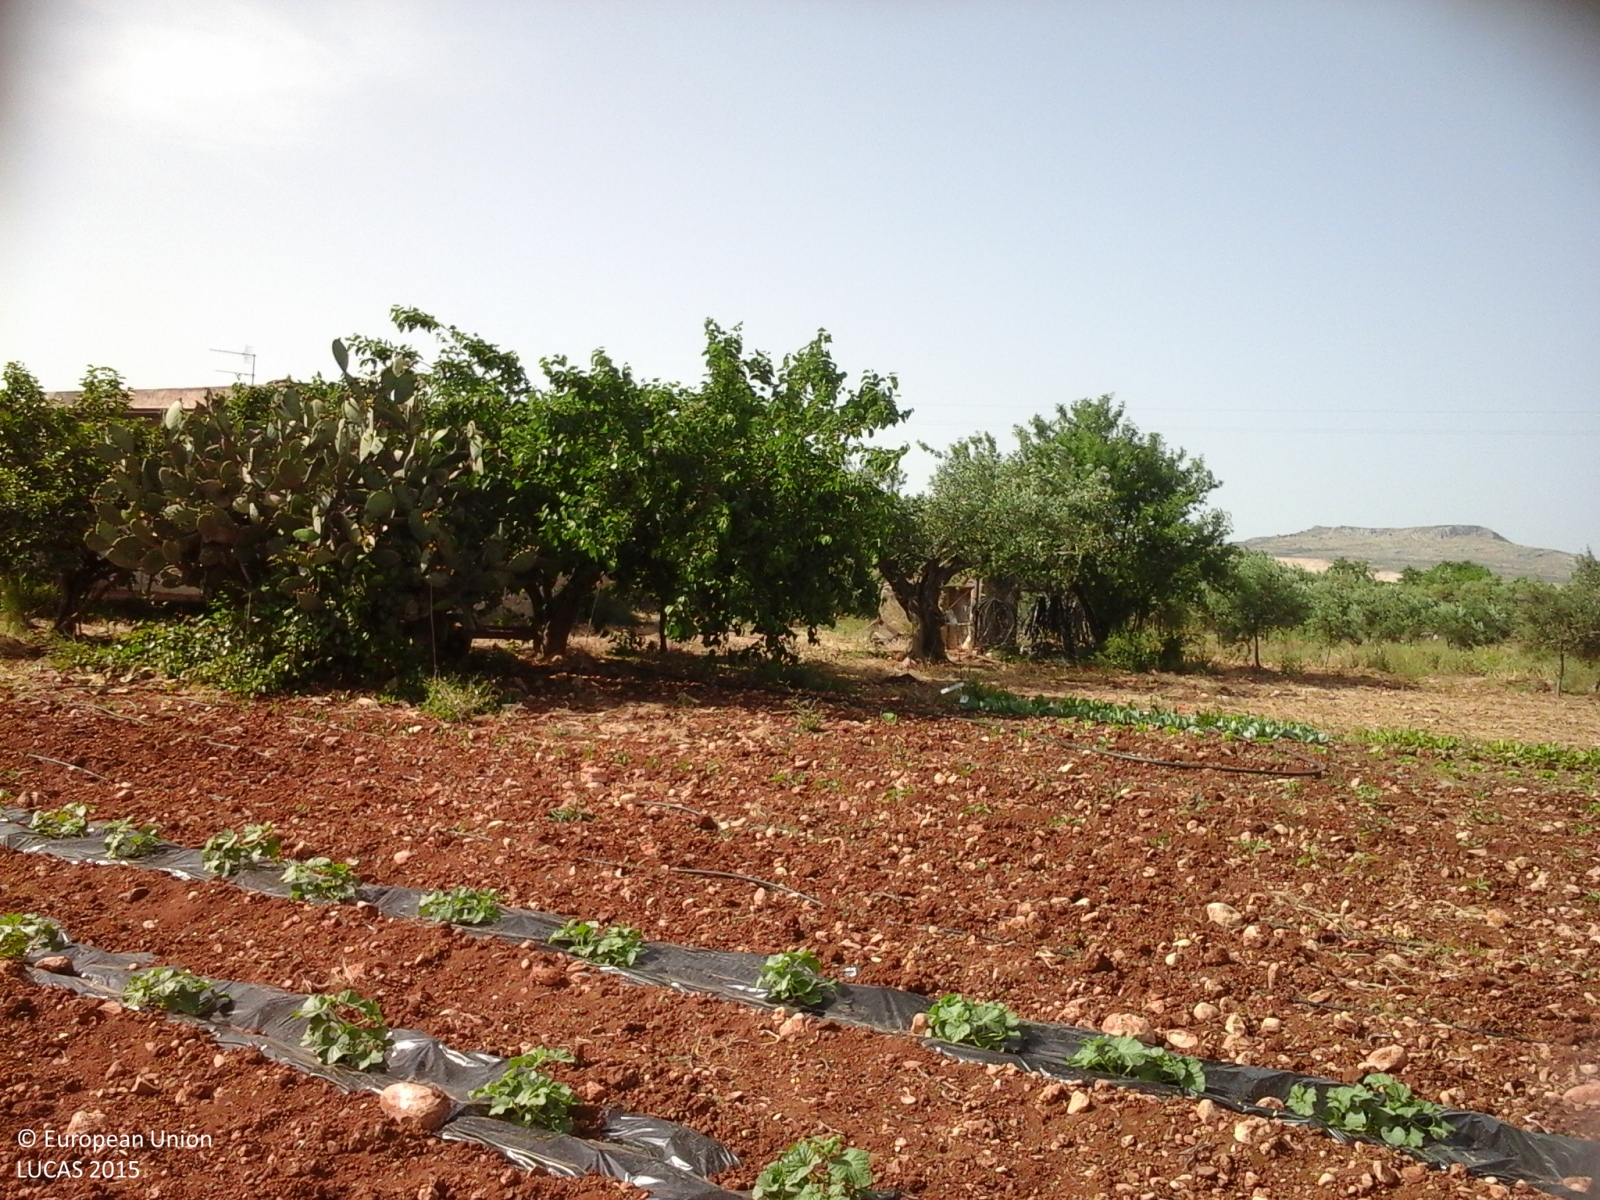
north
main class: Cropland
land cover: Other fresh vegetables
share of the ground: 10 - 25 %
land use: Agriculture (excluding fallow land and kitchen gardens)
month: May
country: IT
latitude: 37.5709
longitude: 13.0676
